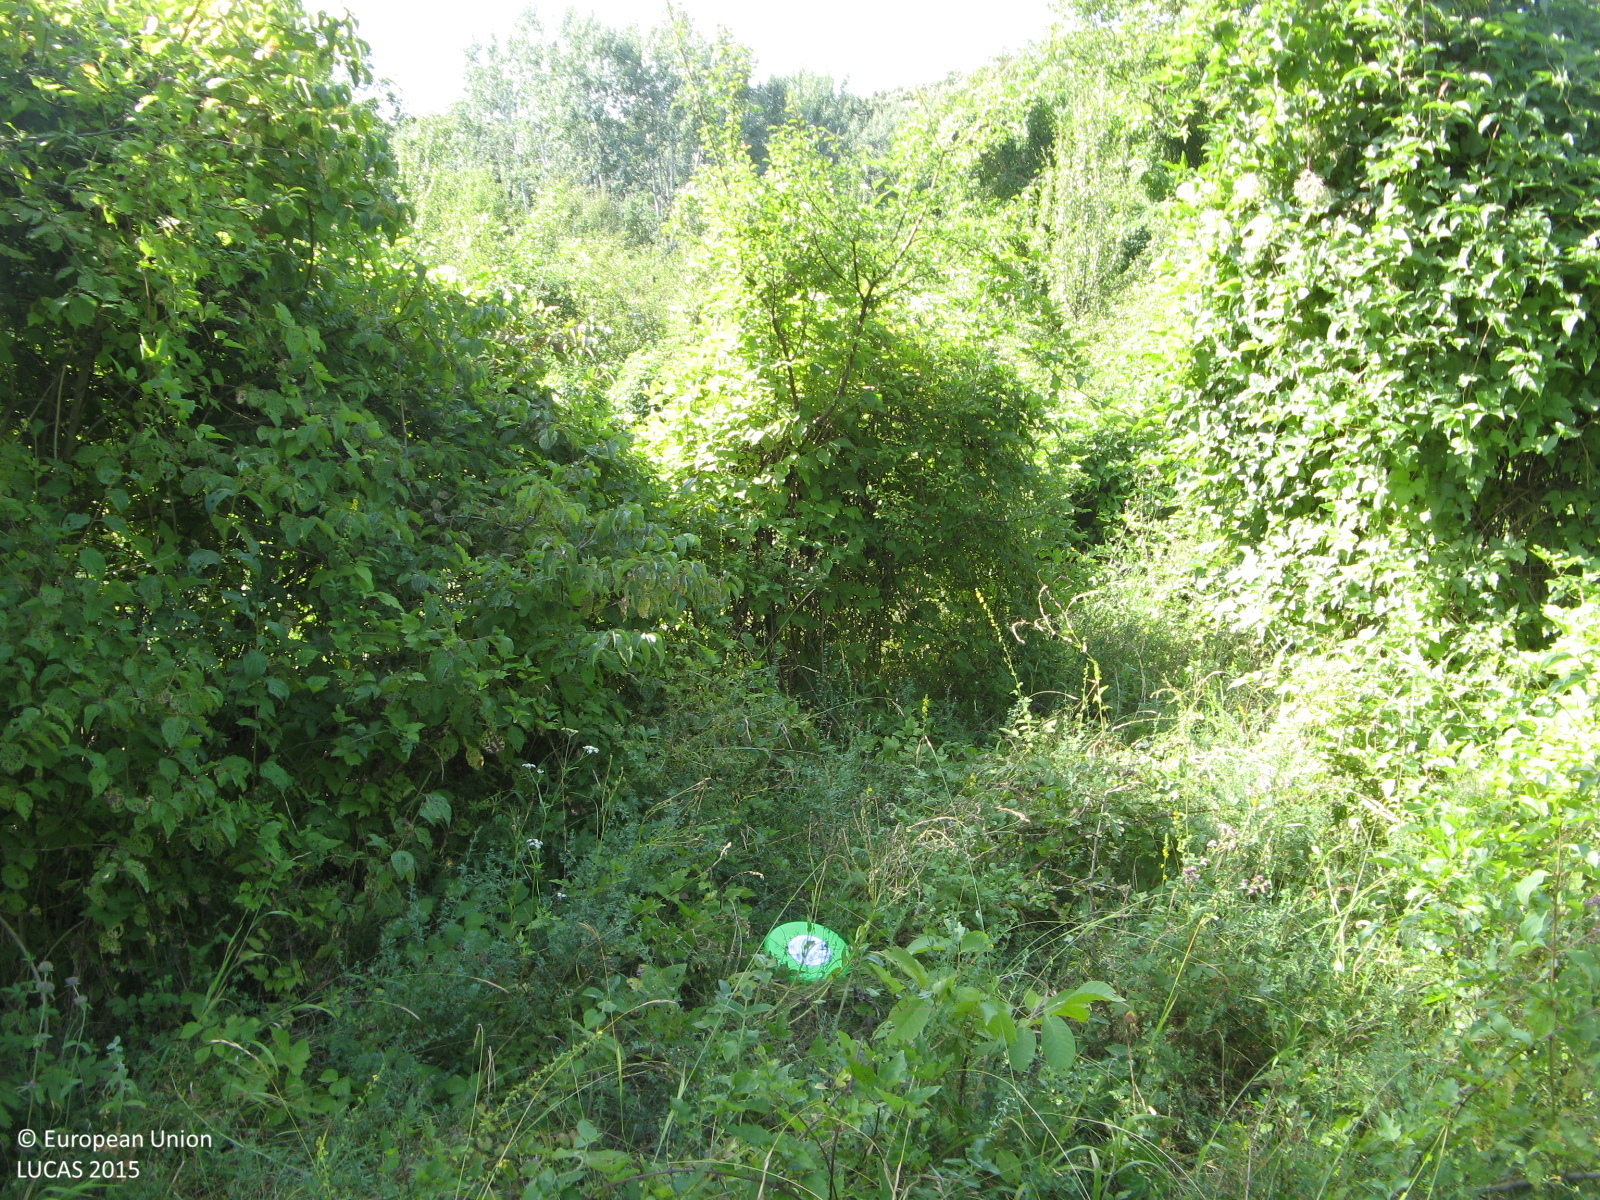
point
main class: Woodland
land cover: Broadleaved woodland
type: thermophilous deciduous forest
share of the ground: > 75 %
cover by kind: broadleaved forest trees 85 %, shrubs 10 %, herbaceous plants 5 %
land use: Forestry
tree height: > 5 m
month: August
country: BG
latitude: 43.5678
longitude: 25.3452
